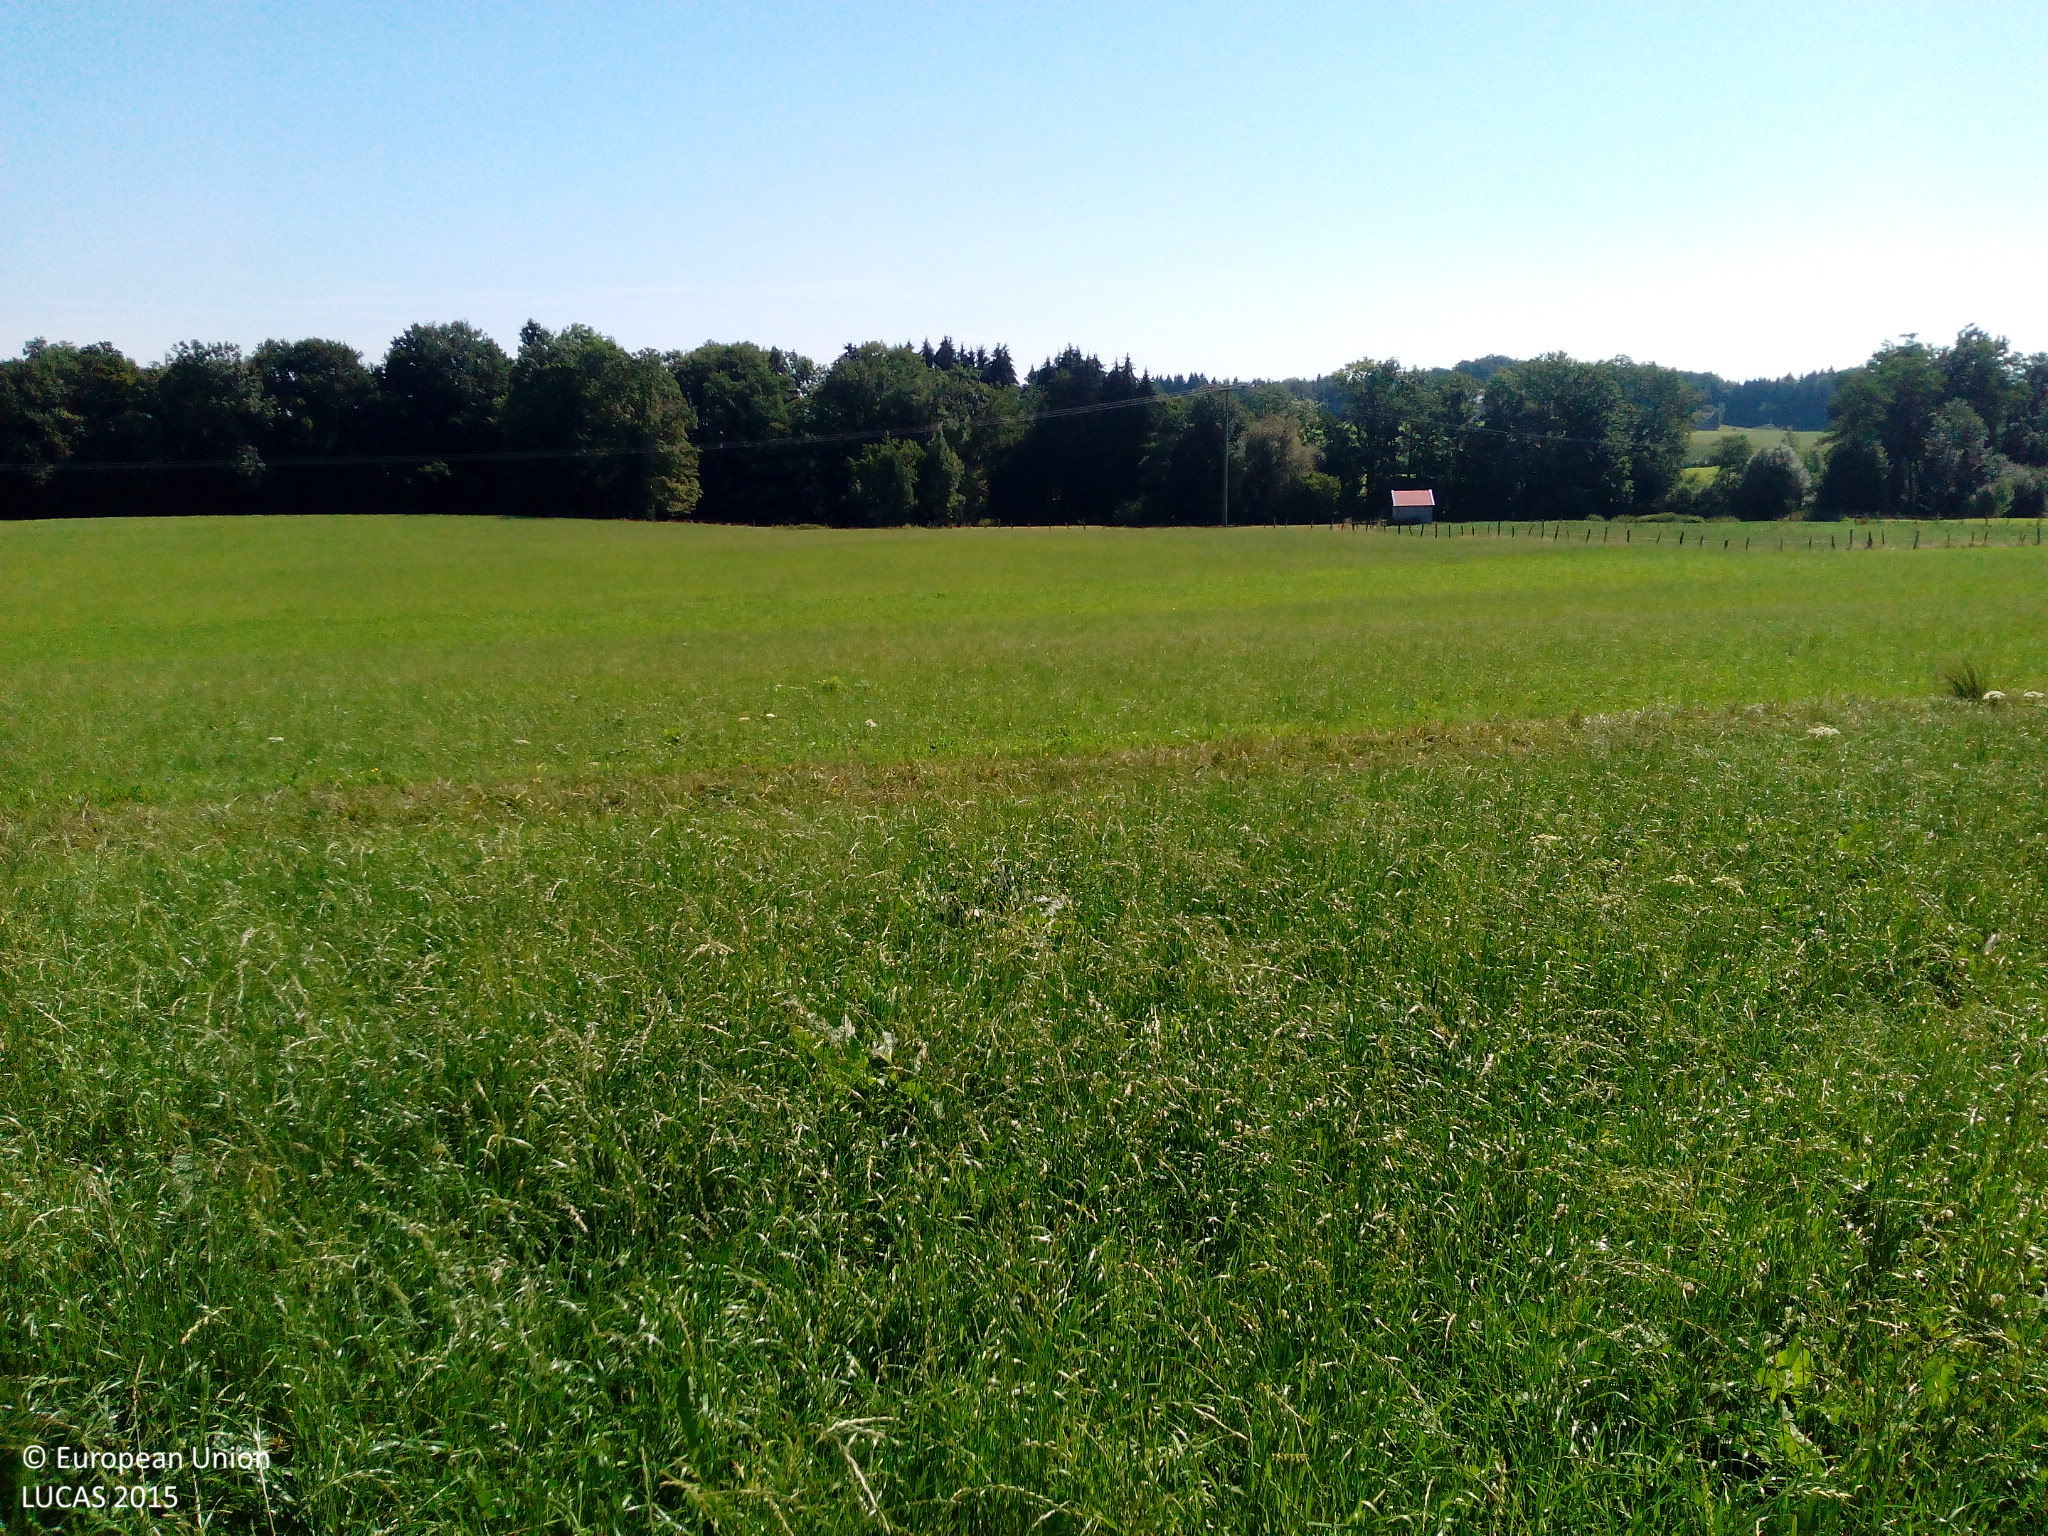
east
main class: Grassland
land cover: Grassland without tree/shrub cover
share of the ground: > 75 %
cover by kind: herbaceous plants 100 %
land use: Agriculture (excluding fallow land and kitchen gardens)
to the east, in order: Grassland without tree/shrub cover; Tracks; Grassland without tree/shrub cover; Electric lines; Grassland without tree/shrub cover; Fences; Grassland without tree/shrub cover; Fences; Broadleaved woodland; Rivers and streams; Broadleaved woodland; Grassland without tree/shrub cover
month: August
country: DE
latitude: 47.9000
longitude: 12.7944
